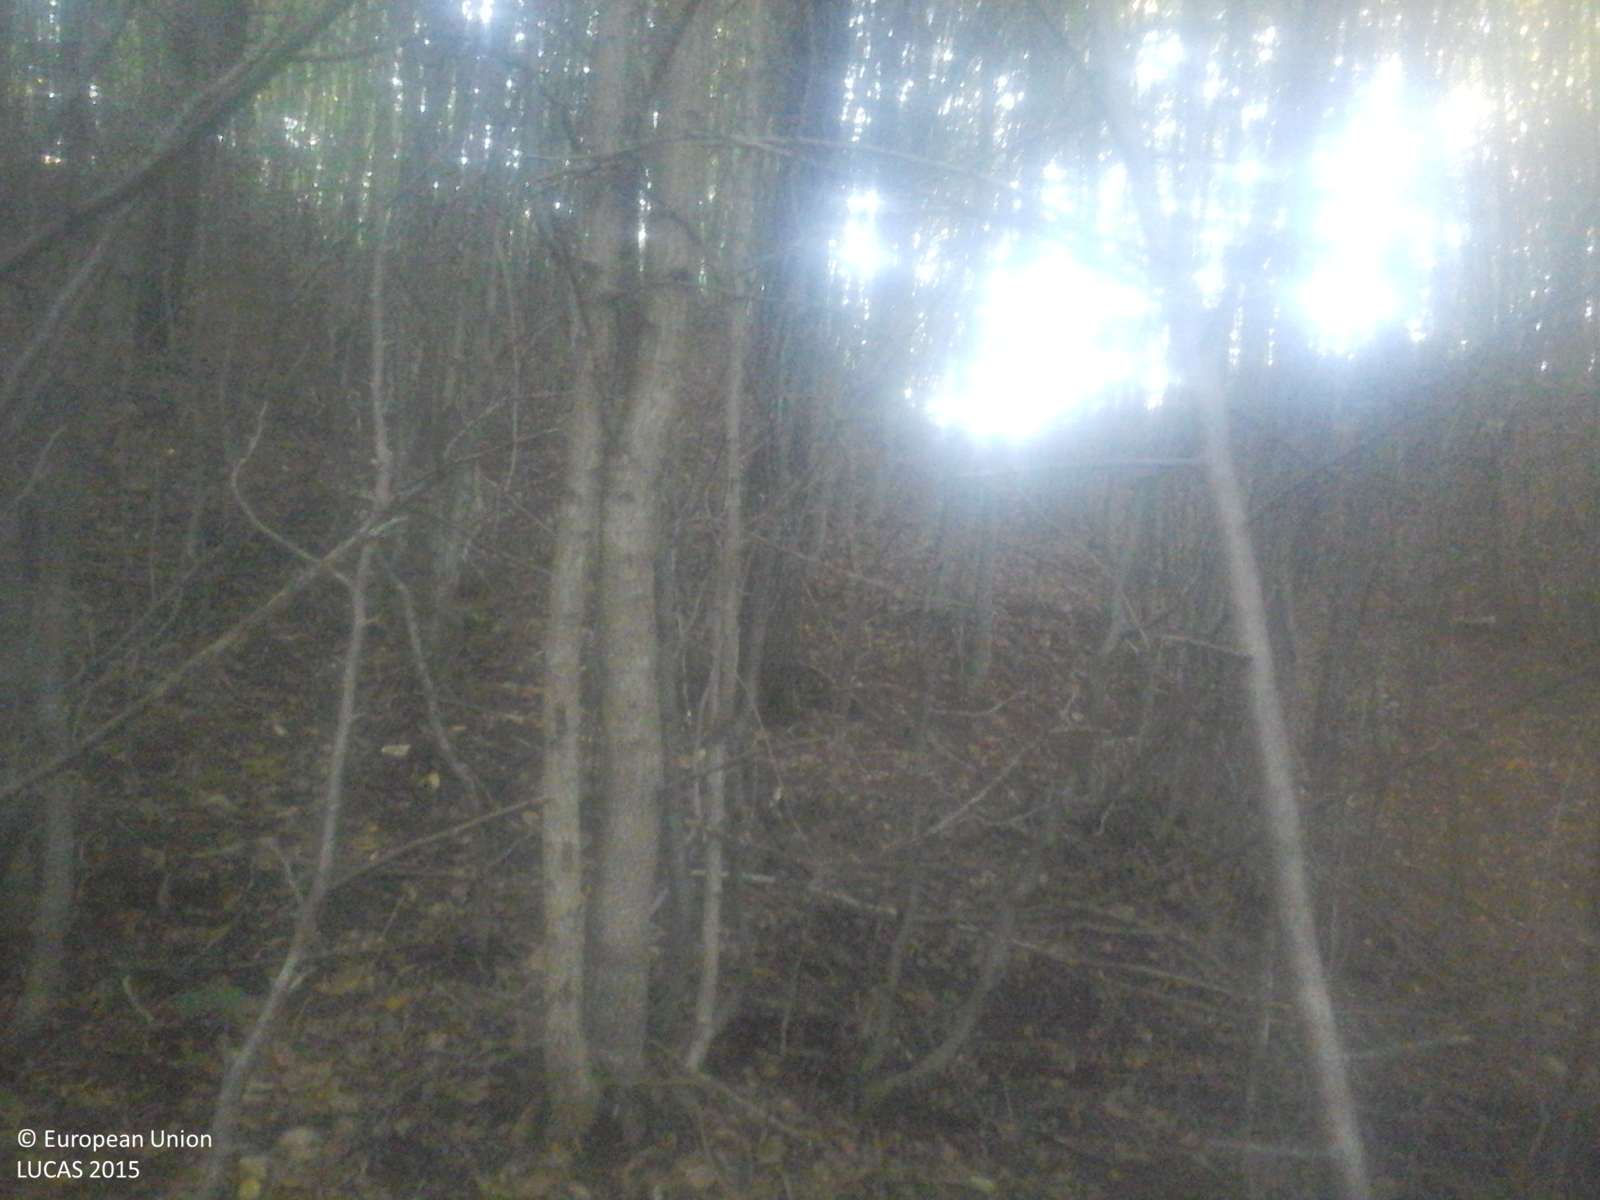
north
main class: Woodland
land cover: Broadleaved woodland
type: beech forest
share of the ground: > 75 %
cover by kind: broadleaved forest trees 100 %
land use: Forestry
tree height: > 5 m
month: October
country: RO
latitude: 46.4845
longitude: 23.5775
